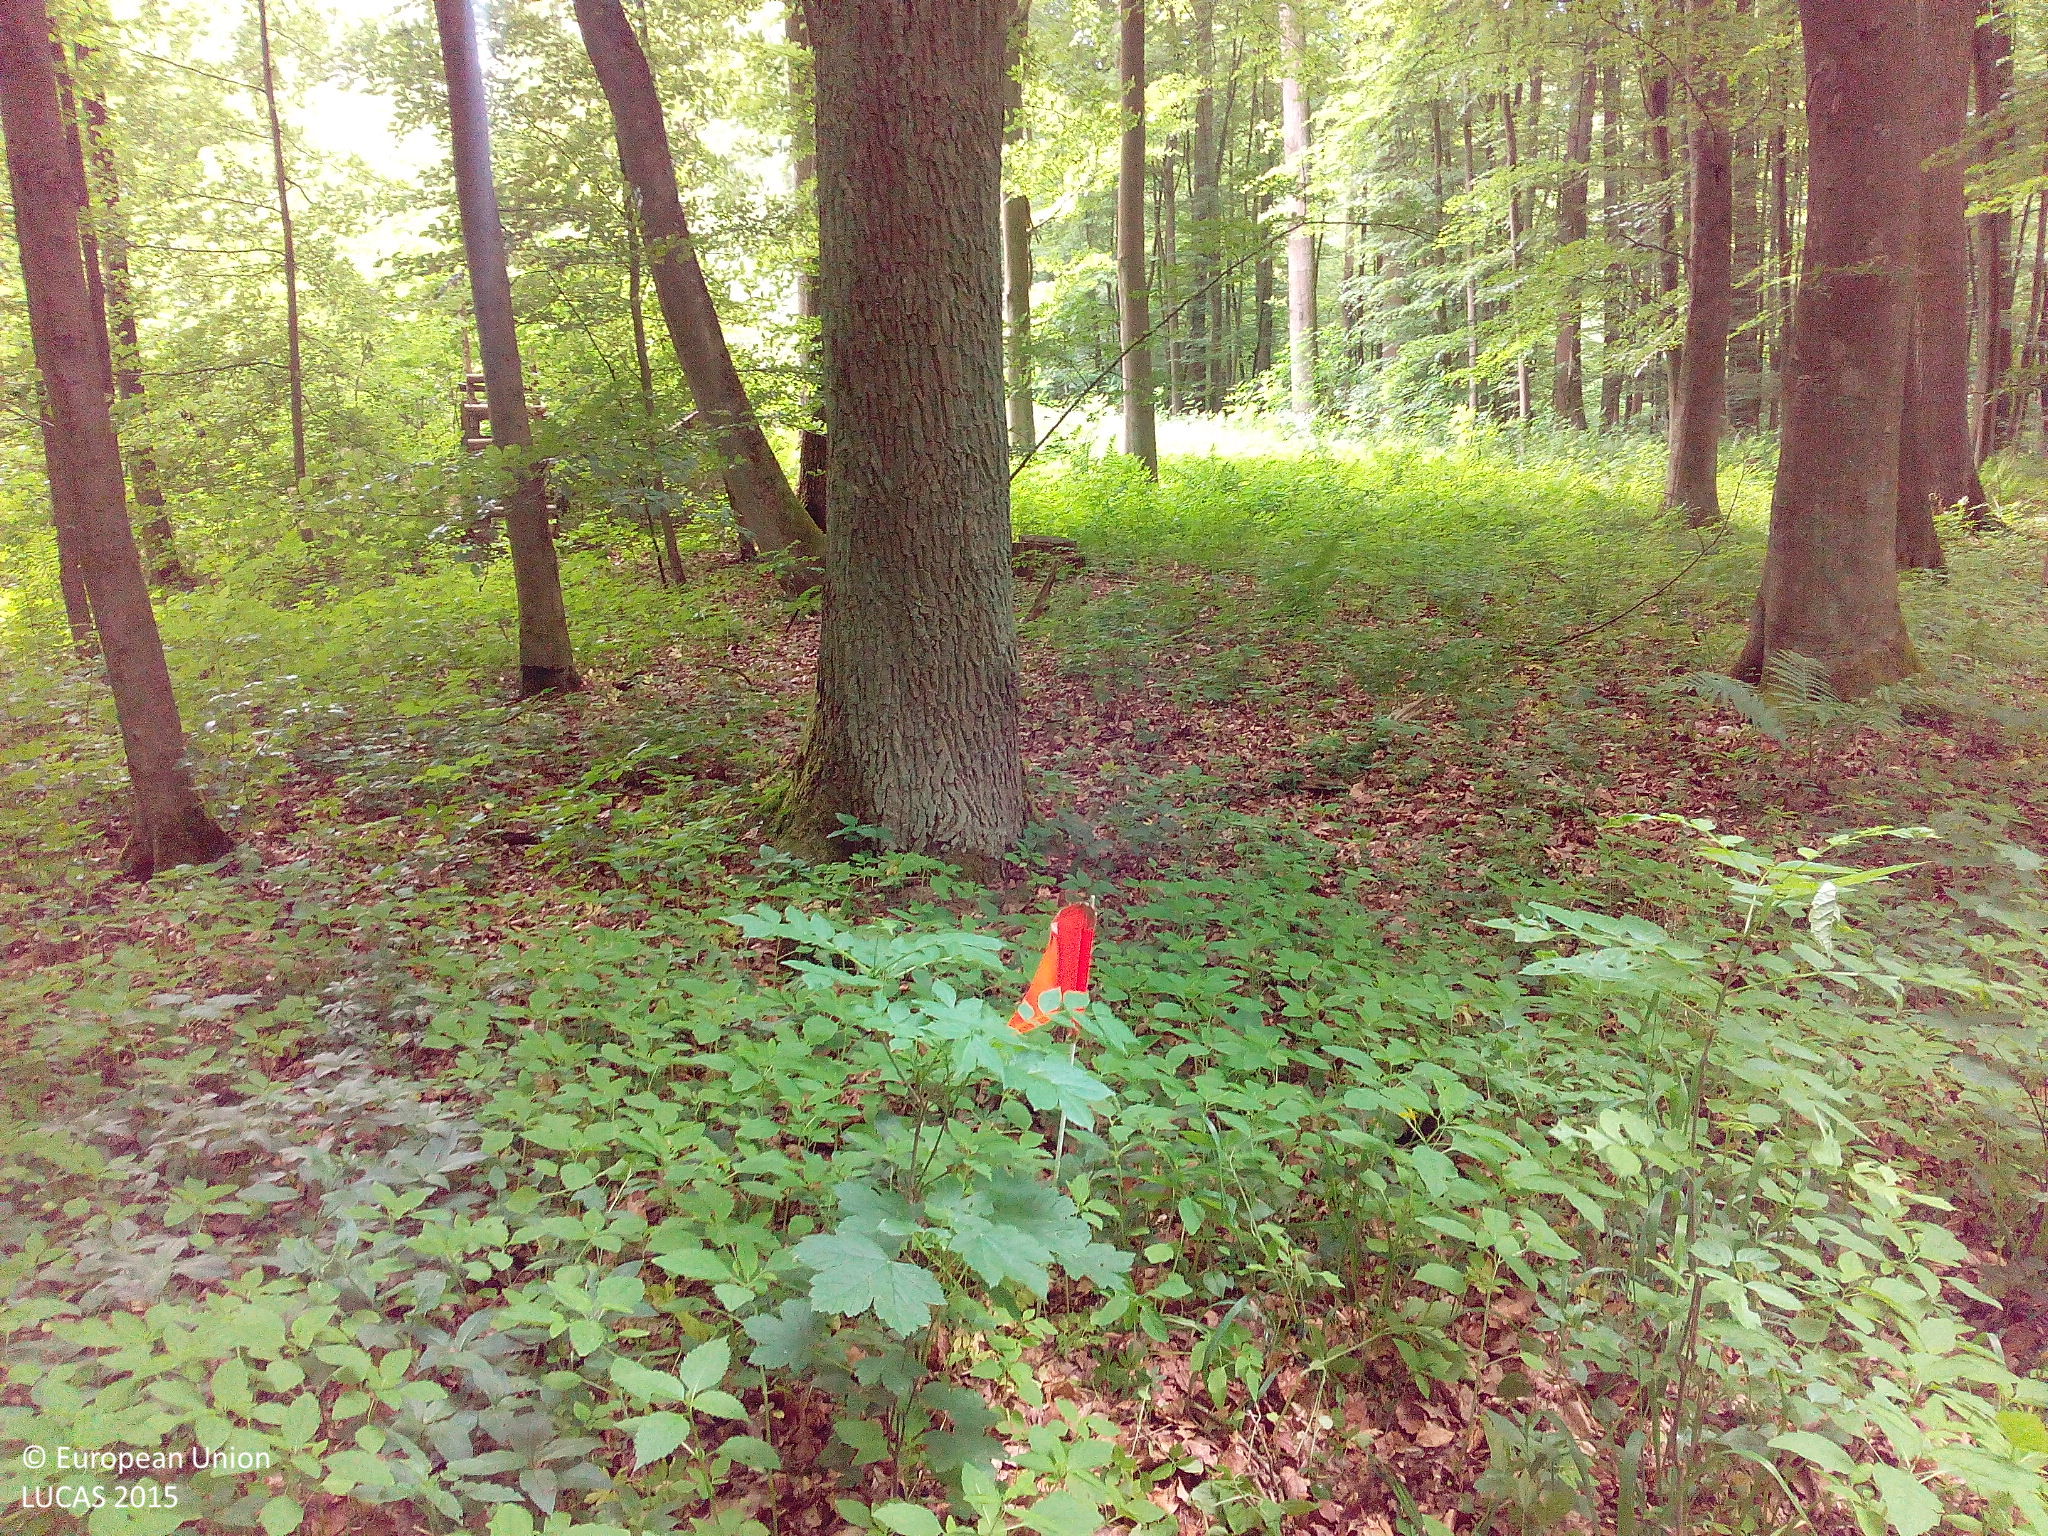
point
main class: Woodland
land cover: Broadleaved woodland
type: beech forest
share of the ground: > 75 %
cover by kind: broadleaved forest trees 100 %
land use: Forestry
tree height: > 5 m
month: June
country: DE
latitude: 51.2612
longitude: 9.3553
